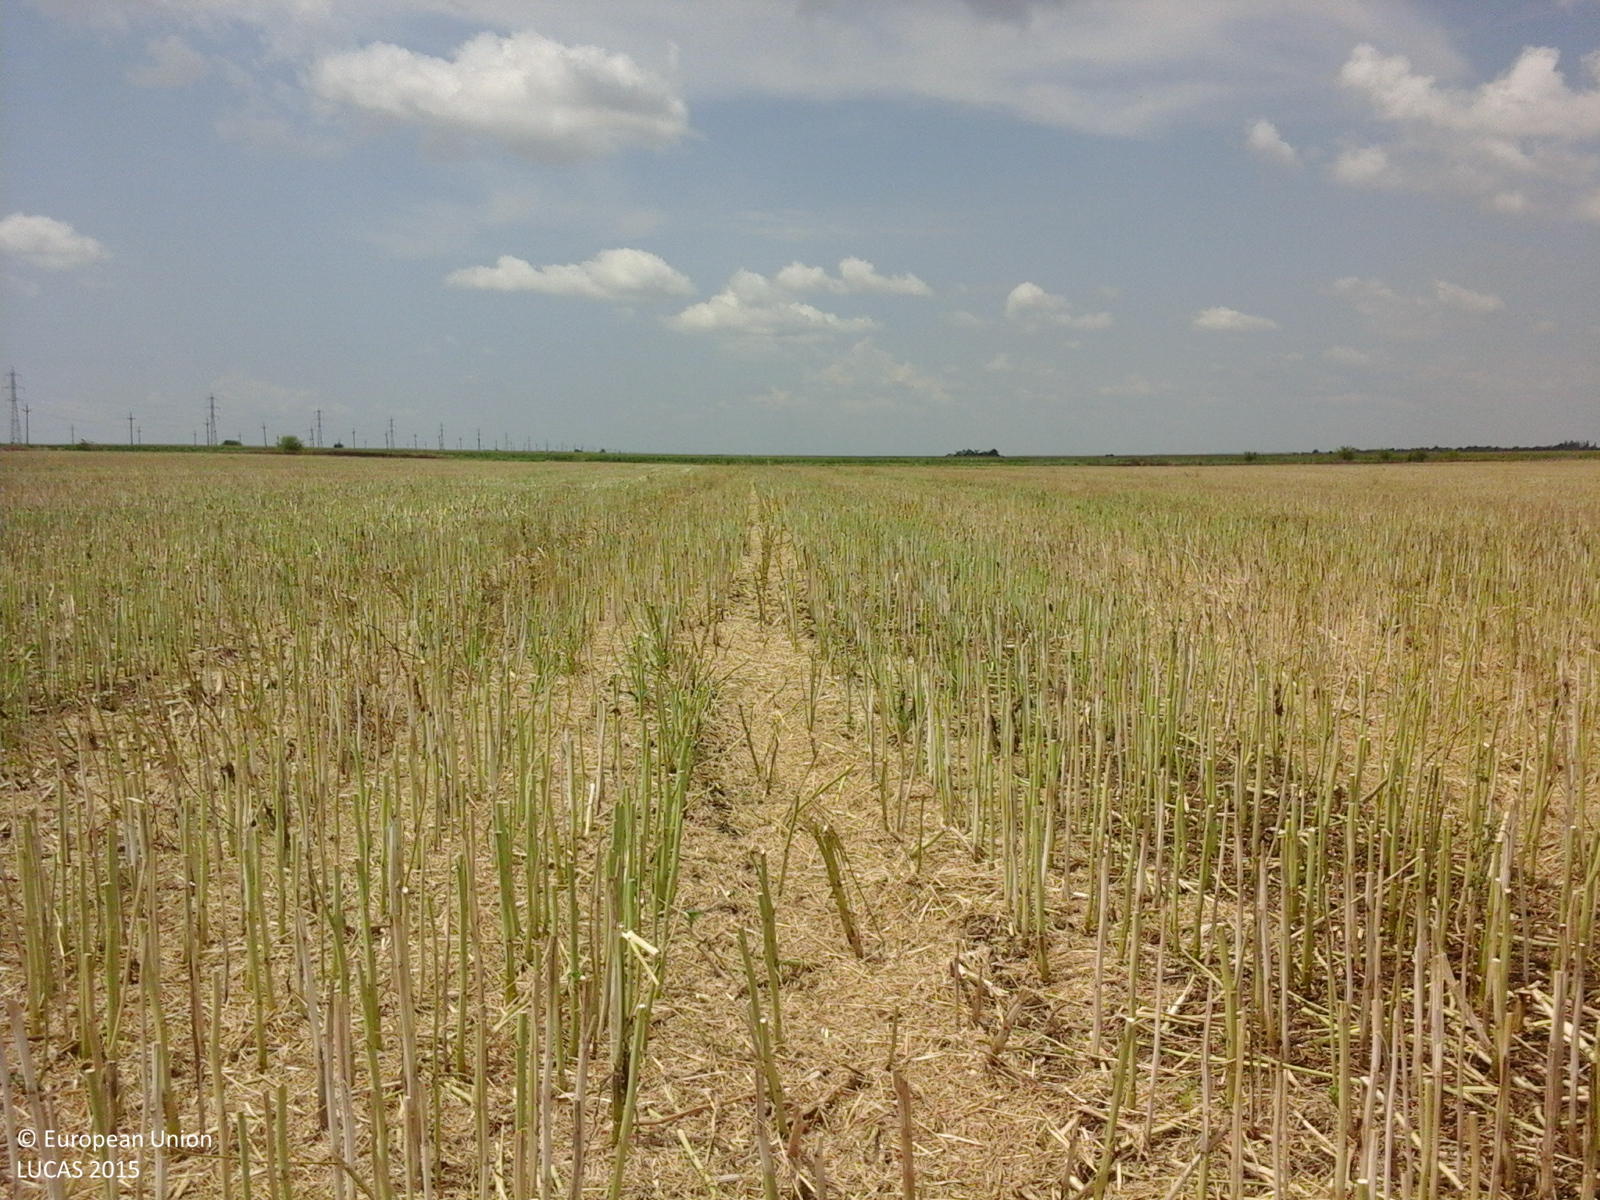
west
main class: Cropland
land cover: Rape and turnip rape
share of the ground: < 10 %
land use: Agriculture (excluding fallow land and kitchen gardens)
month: July
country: RO
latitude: 43.7916
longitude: 24.4420
